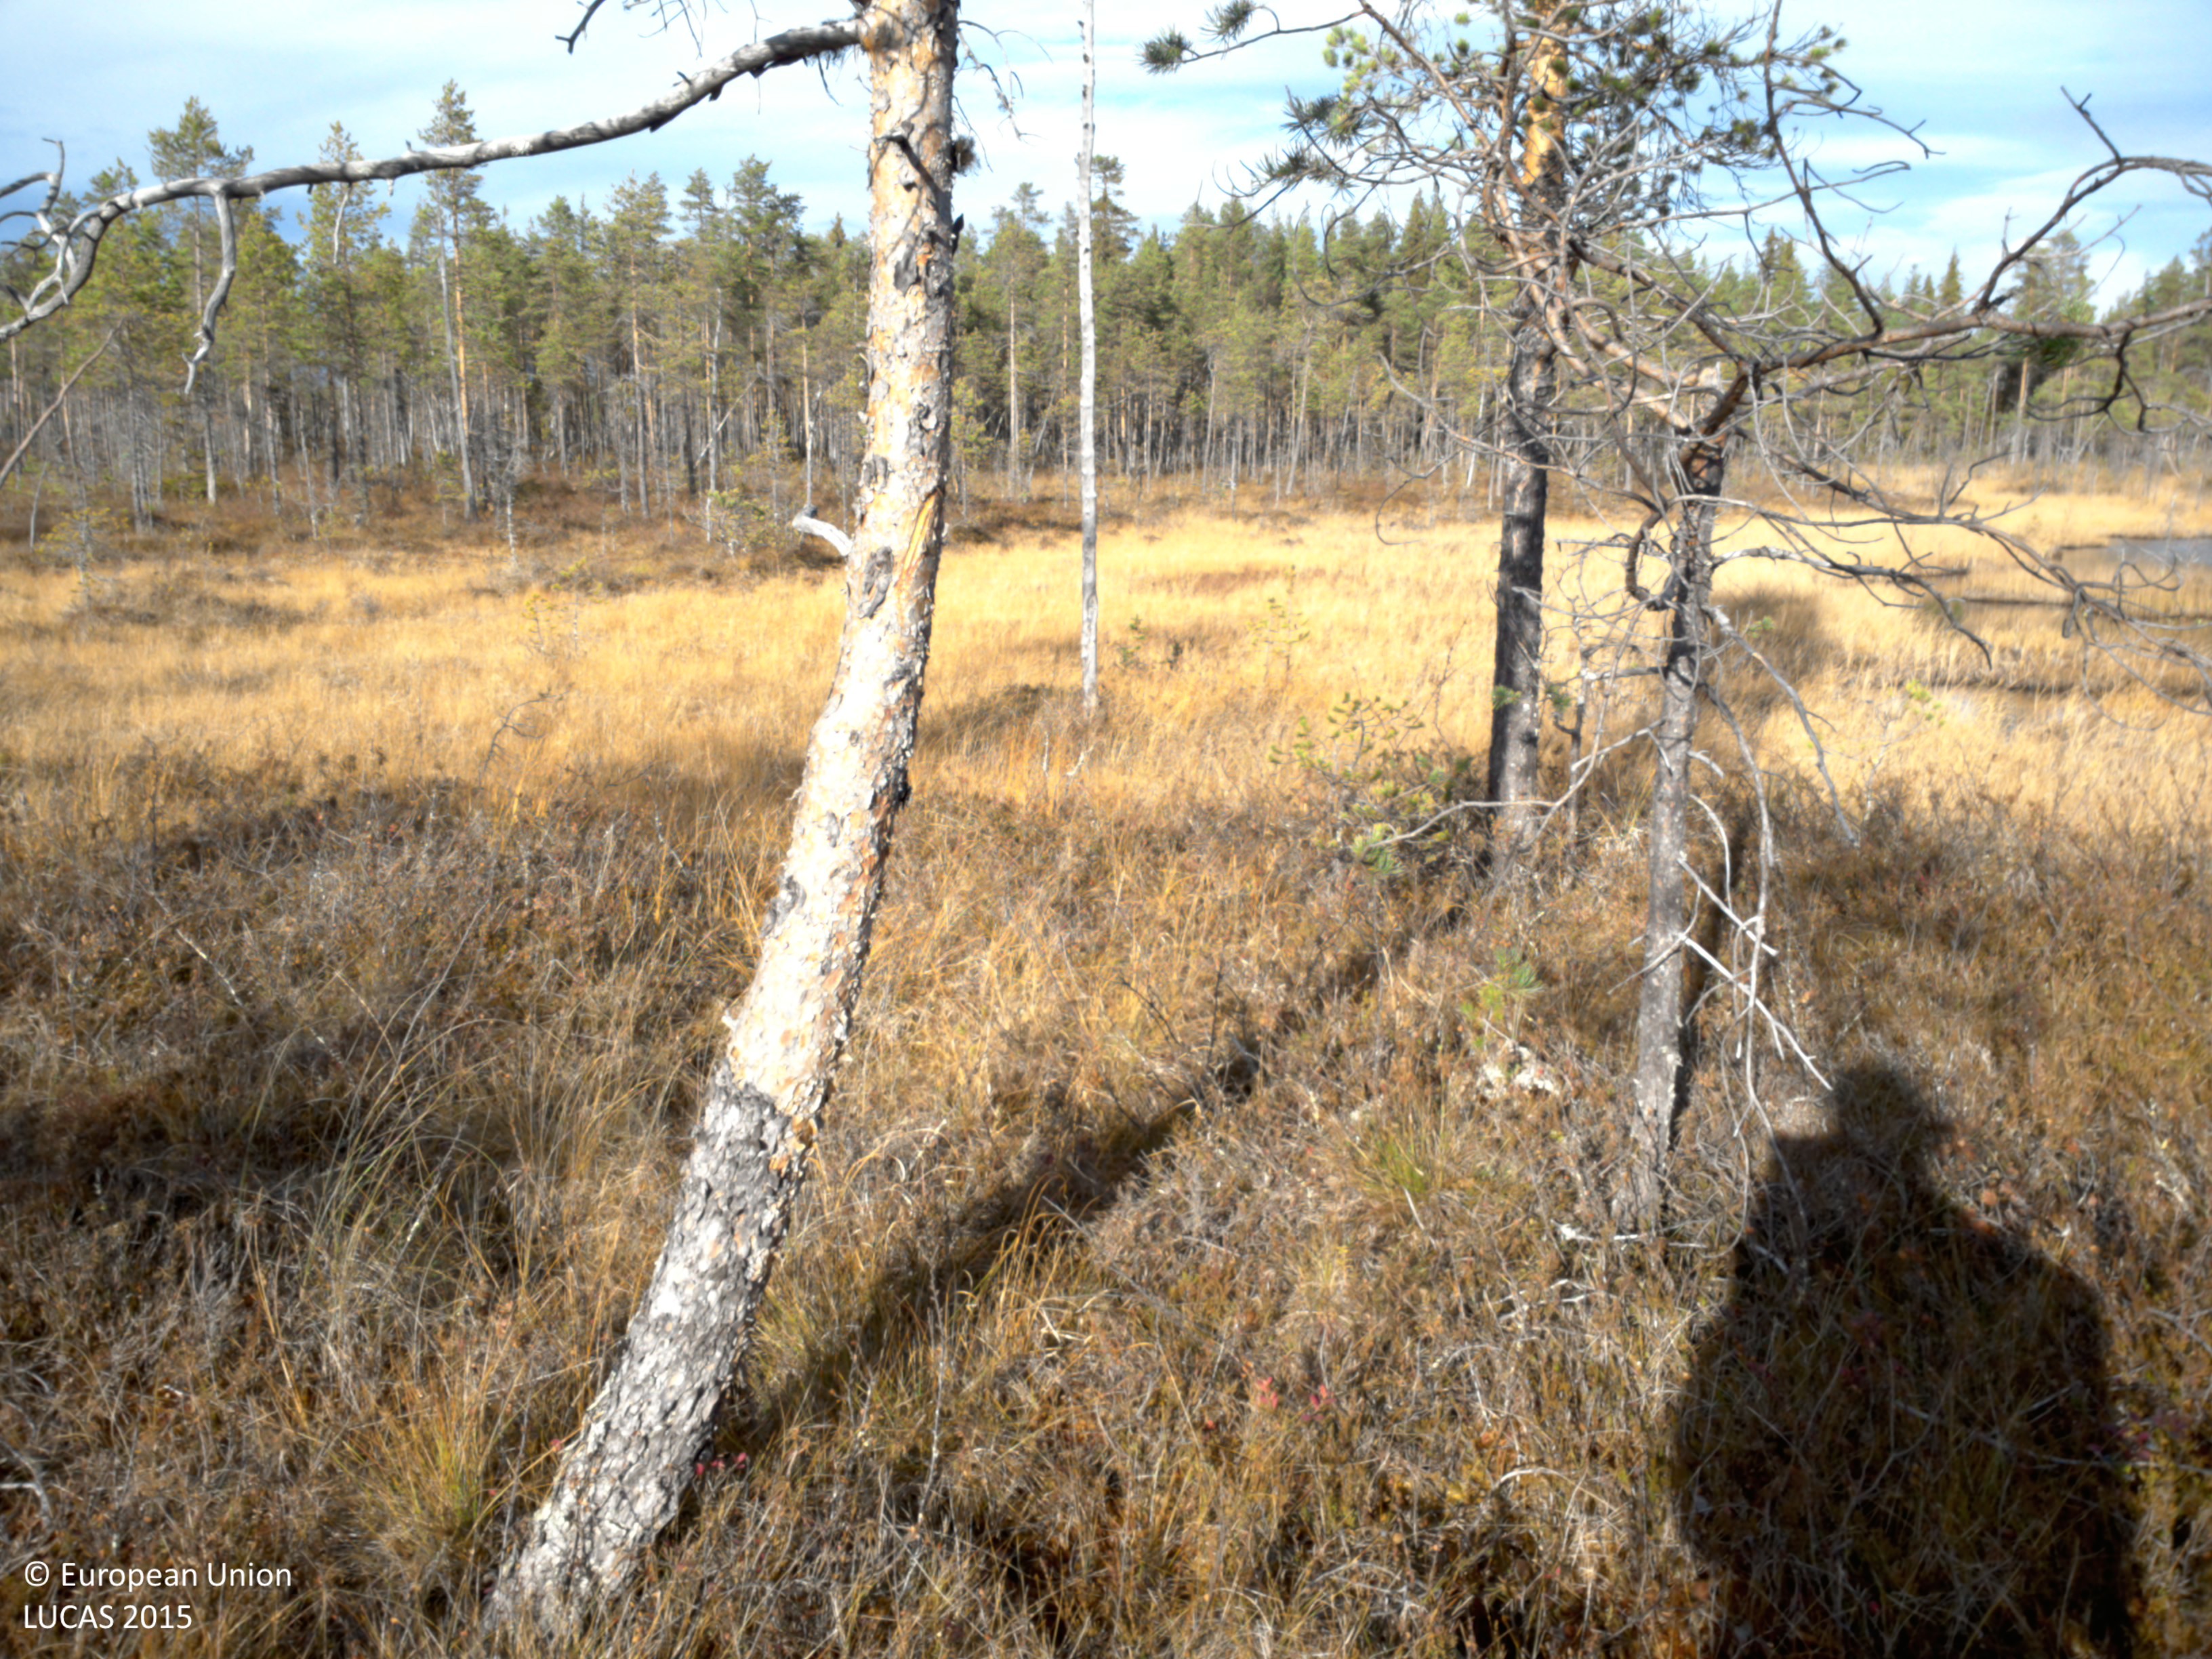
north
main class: Woodland
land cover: Pine dominated coniferous woodland
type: boreal forest
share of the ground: 25 - 50 %
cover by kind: coniferous forest trees 40 %, shrubs 20 %, herbaceous plants 20 %, broadleaved forest trees 10 %, lichens and mosses 10 %
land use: Semi-natural and natural areas not in use
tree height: < 5 m
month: September
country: SE
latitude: 64.8763
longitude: 18.5568
